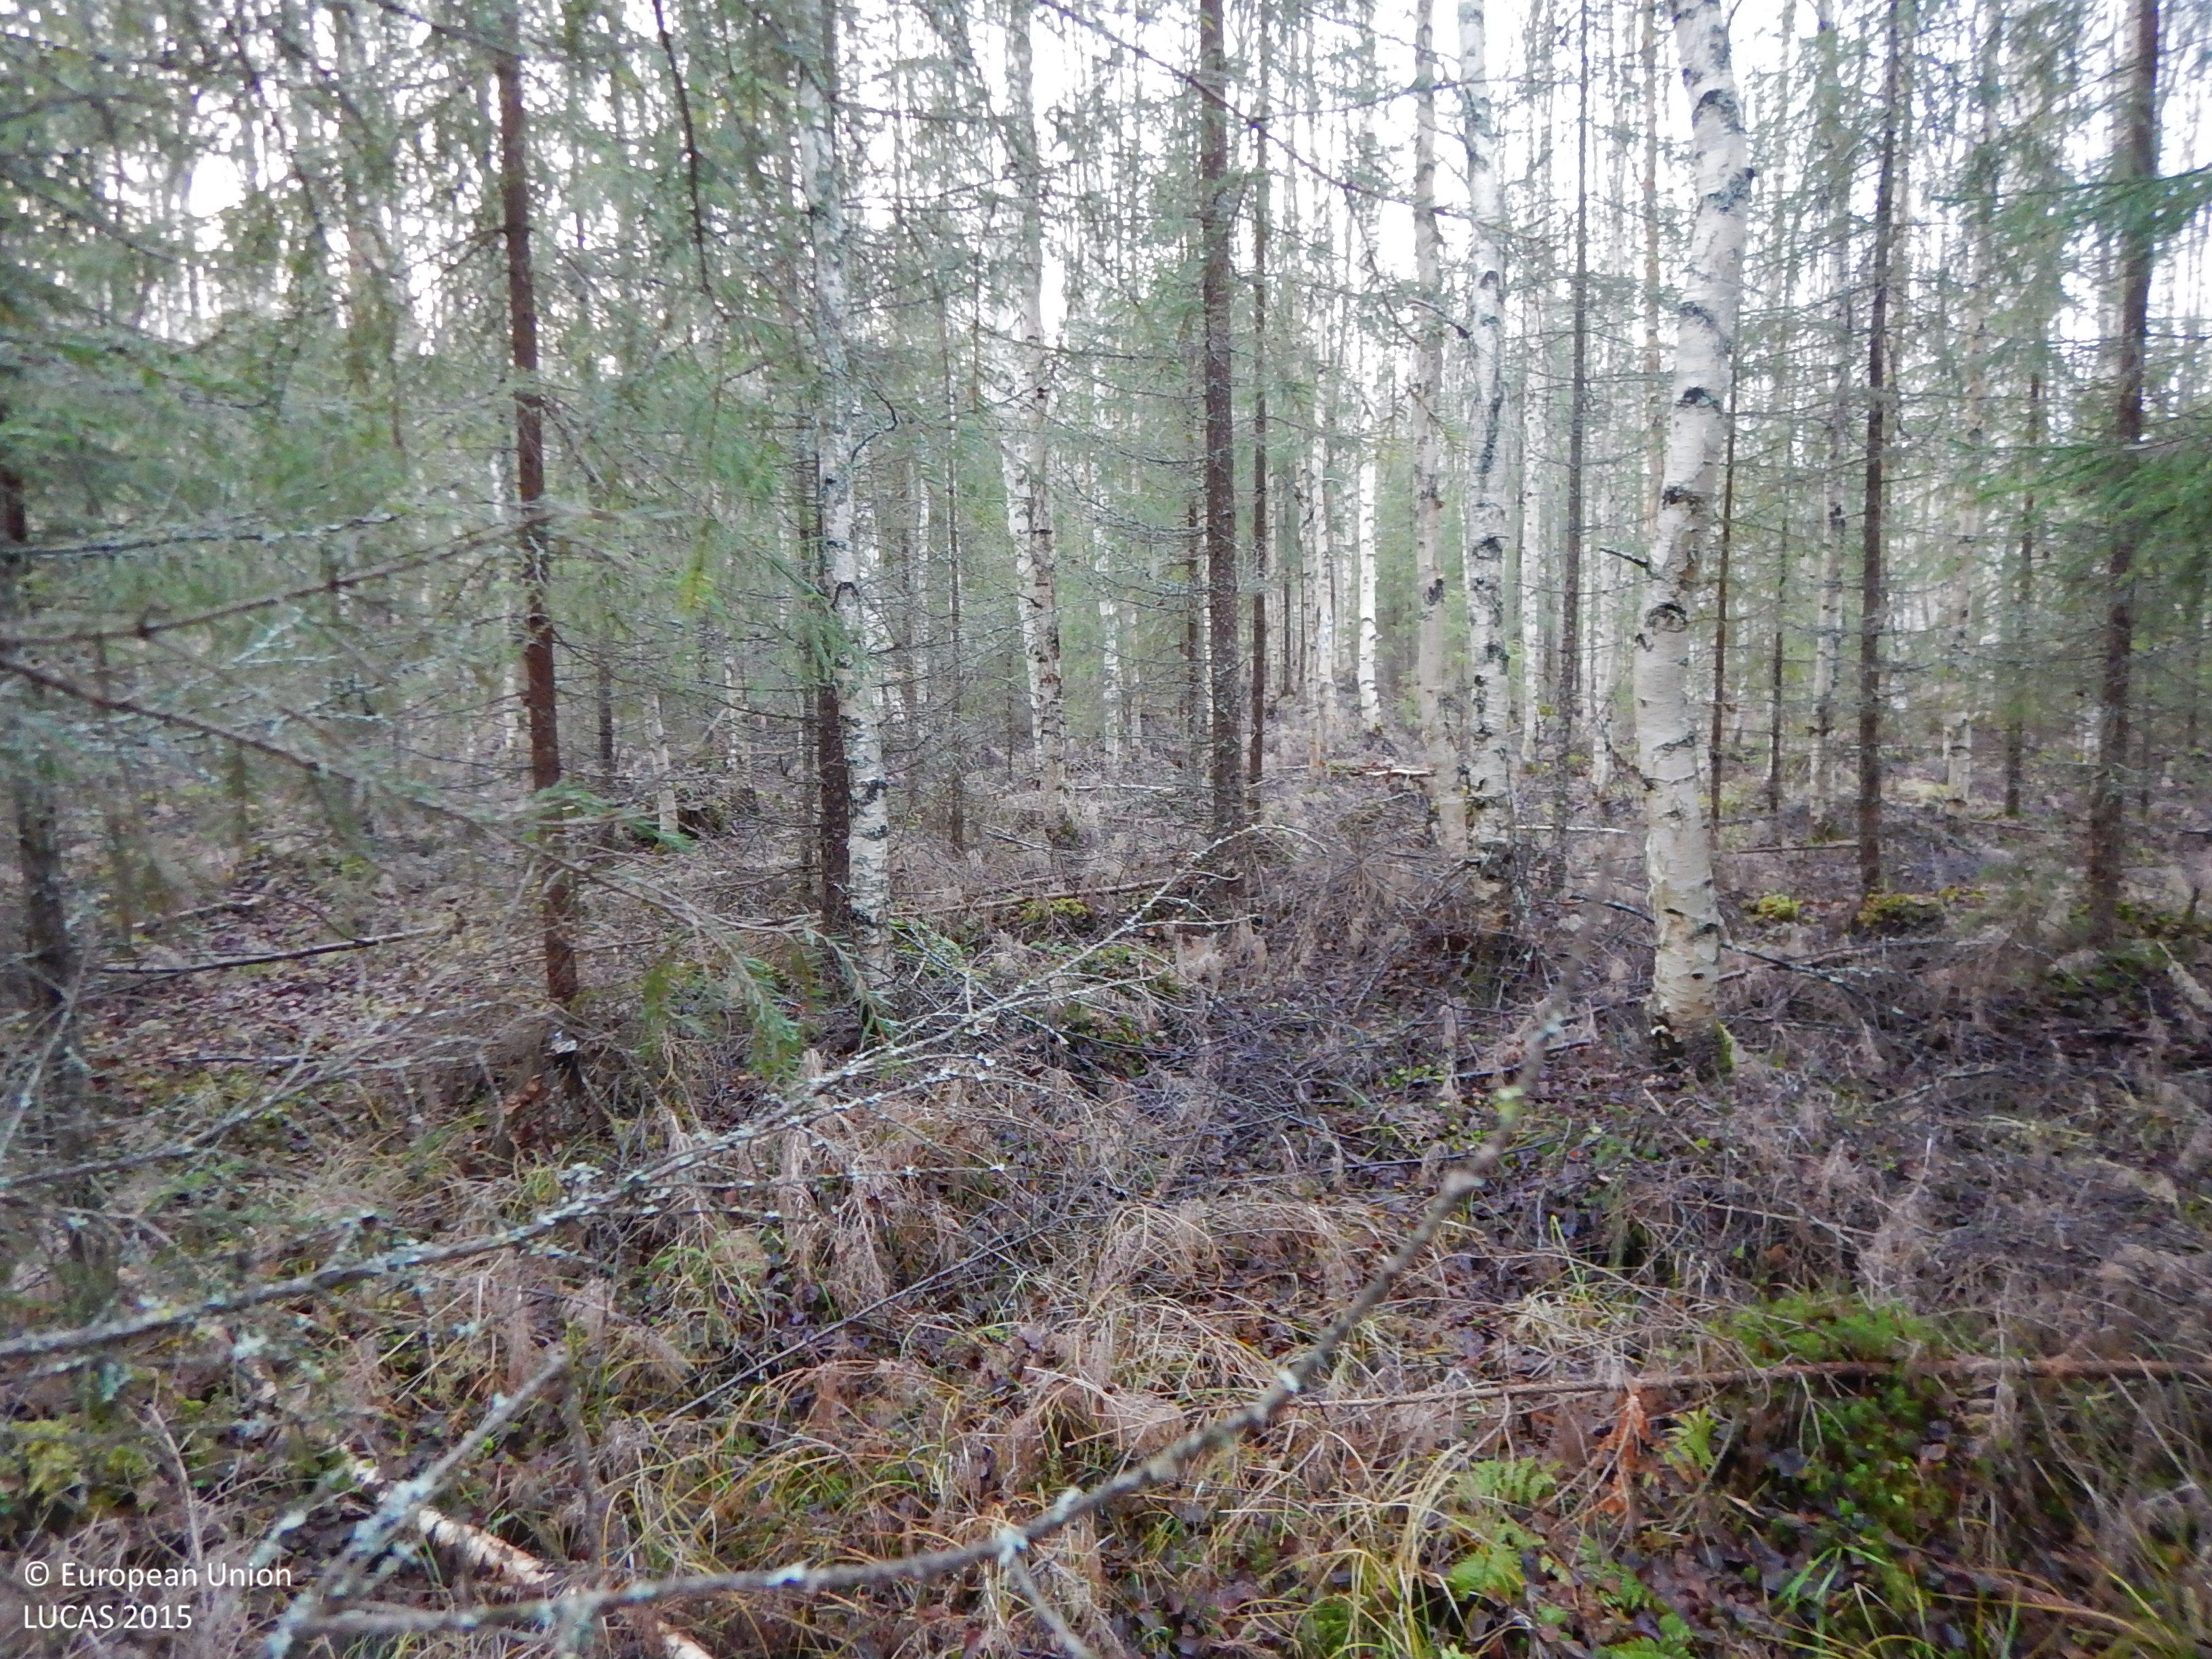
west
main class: Woodland
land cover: Spruce dominated mixed woodland
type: boreal forest
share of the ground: 50 - 75 %
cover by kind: coniferous forest trees 30 %, broadleaved forest trees 30 %, herbaceous plants 20 %, shrubs 10 %, lichens and mosses 10 %
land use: Forestry
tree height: > 5 m
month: October
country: SE
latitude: 65.4063
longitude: 21.2355
